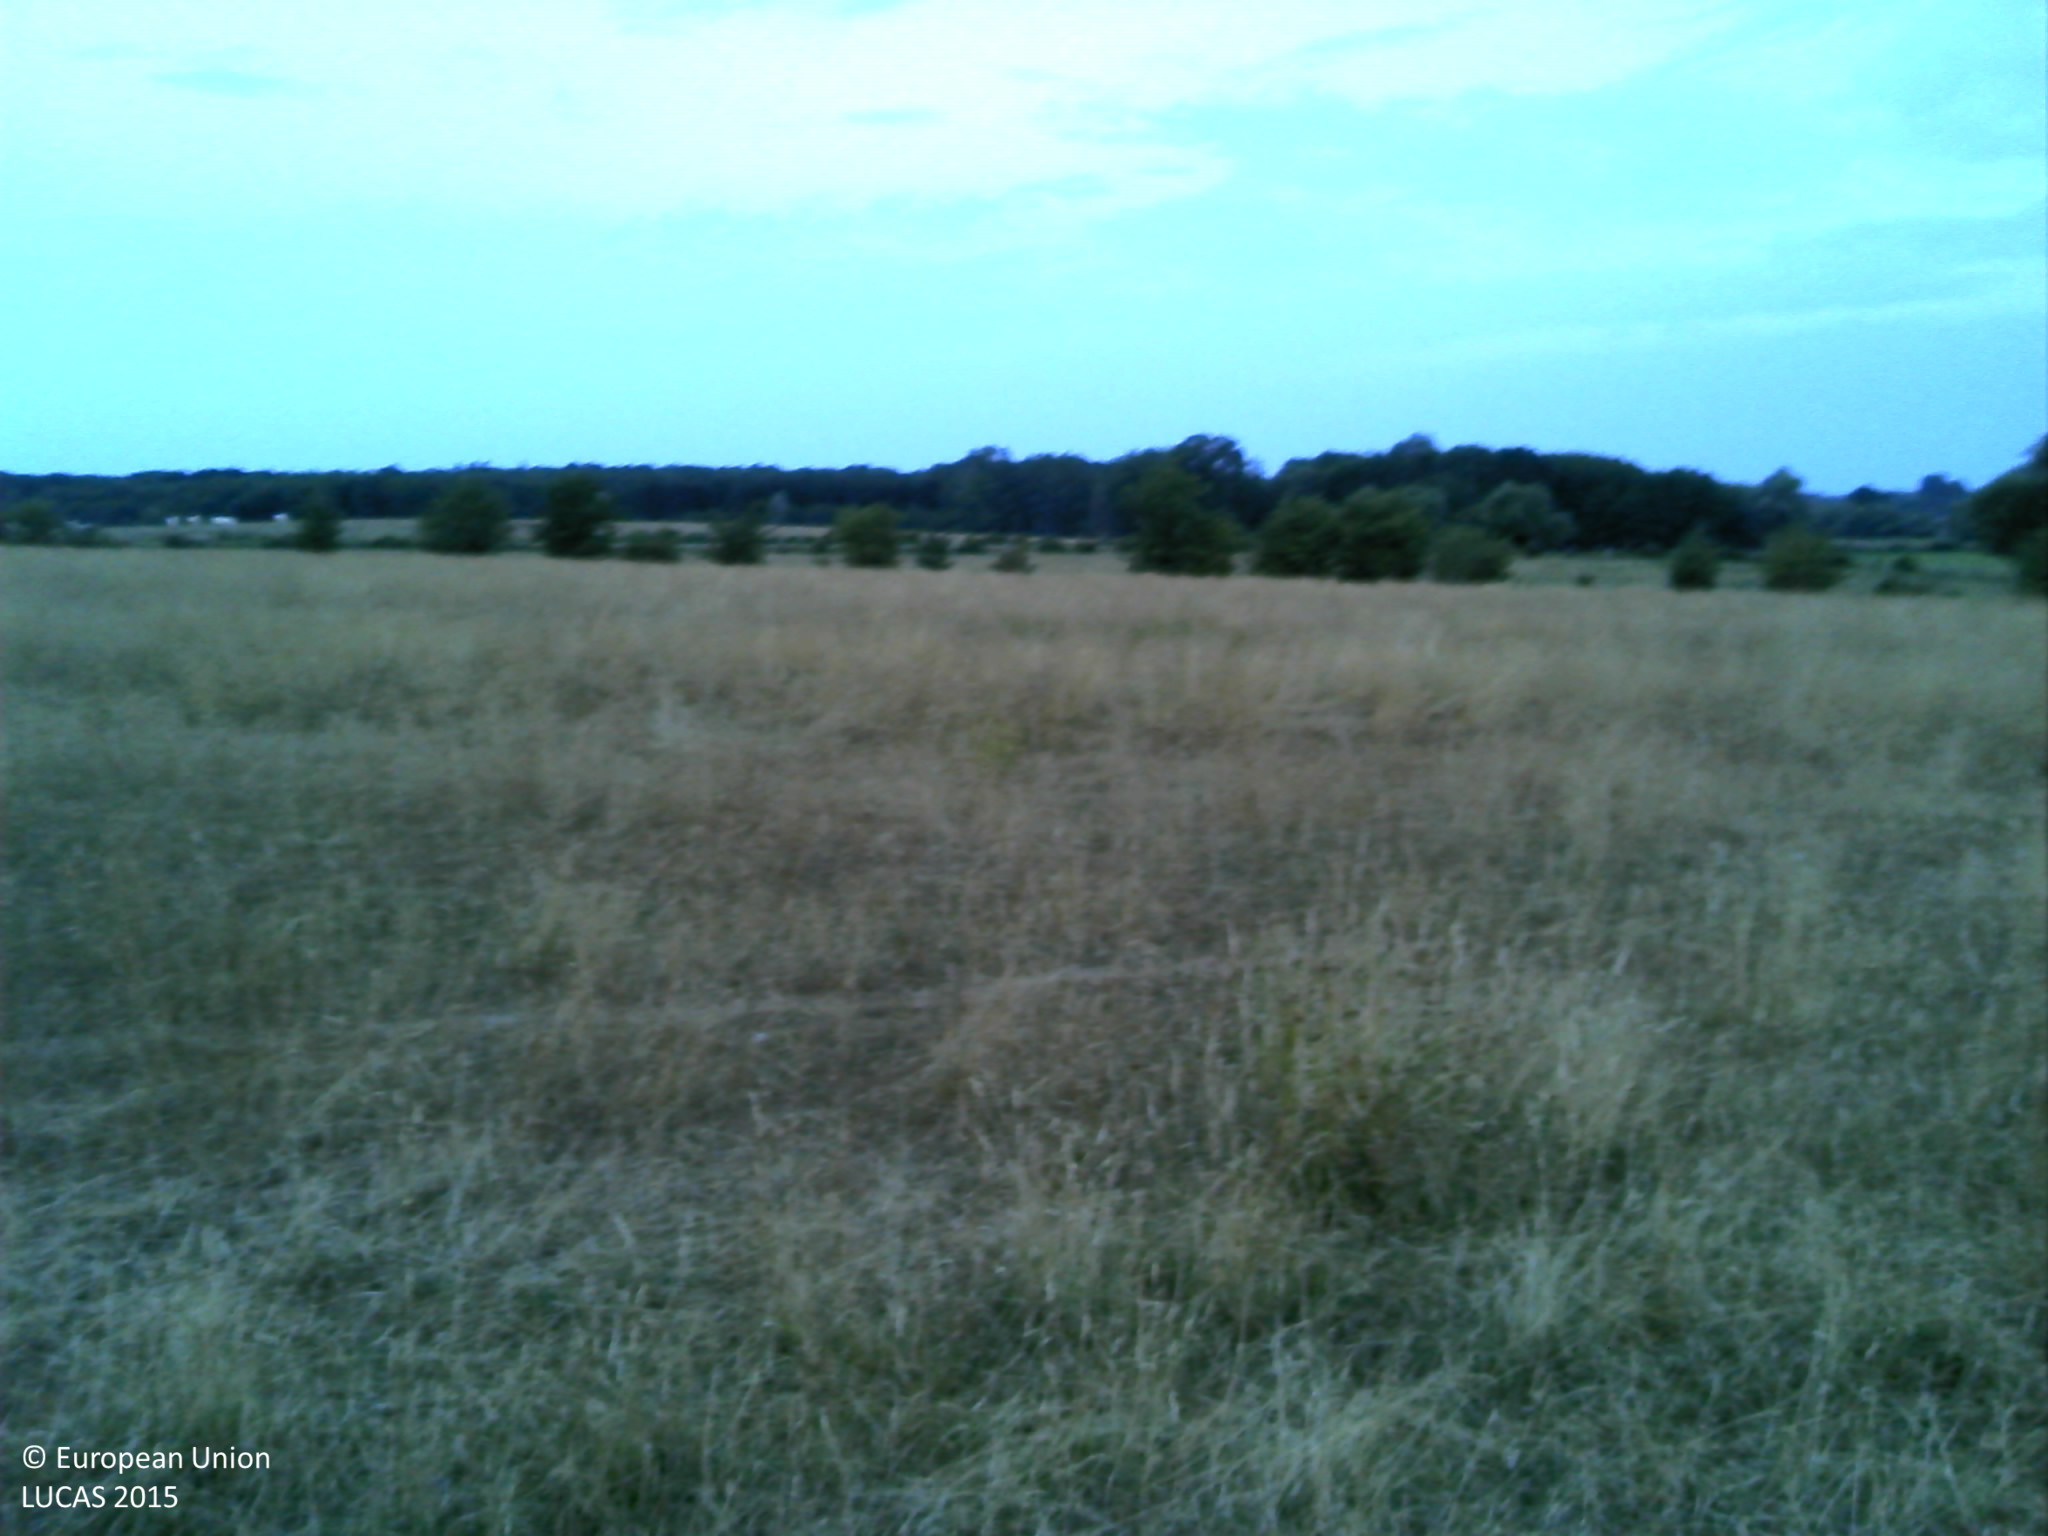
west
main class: Grassland
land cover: Grassland without tree/shrub cover
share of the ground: > 75 %
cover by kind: herbaceous plants 100 %
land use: Agriculture (excluding fallow land and kitchen gardens)
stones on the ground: < 10 %
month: July
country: FR
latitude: 48.2585
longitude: 6.5120
